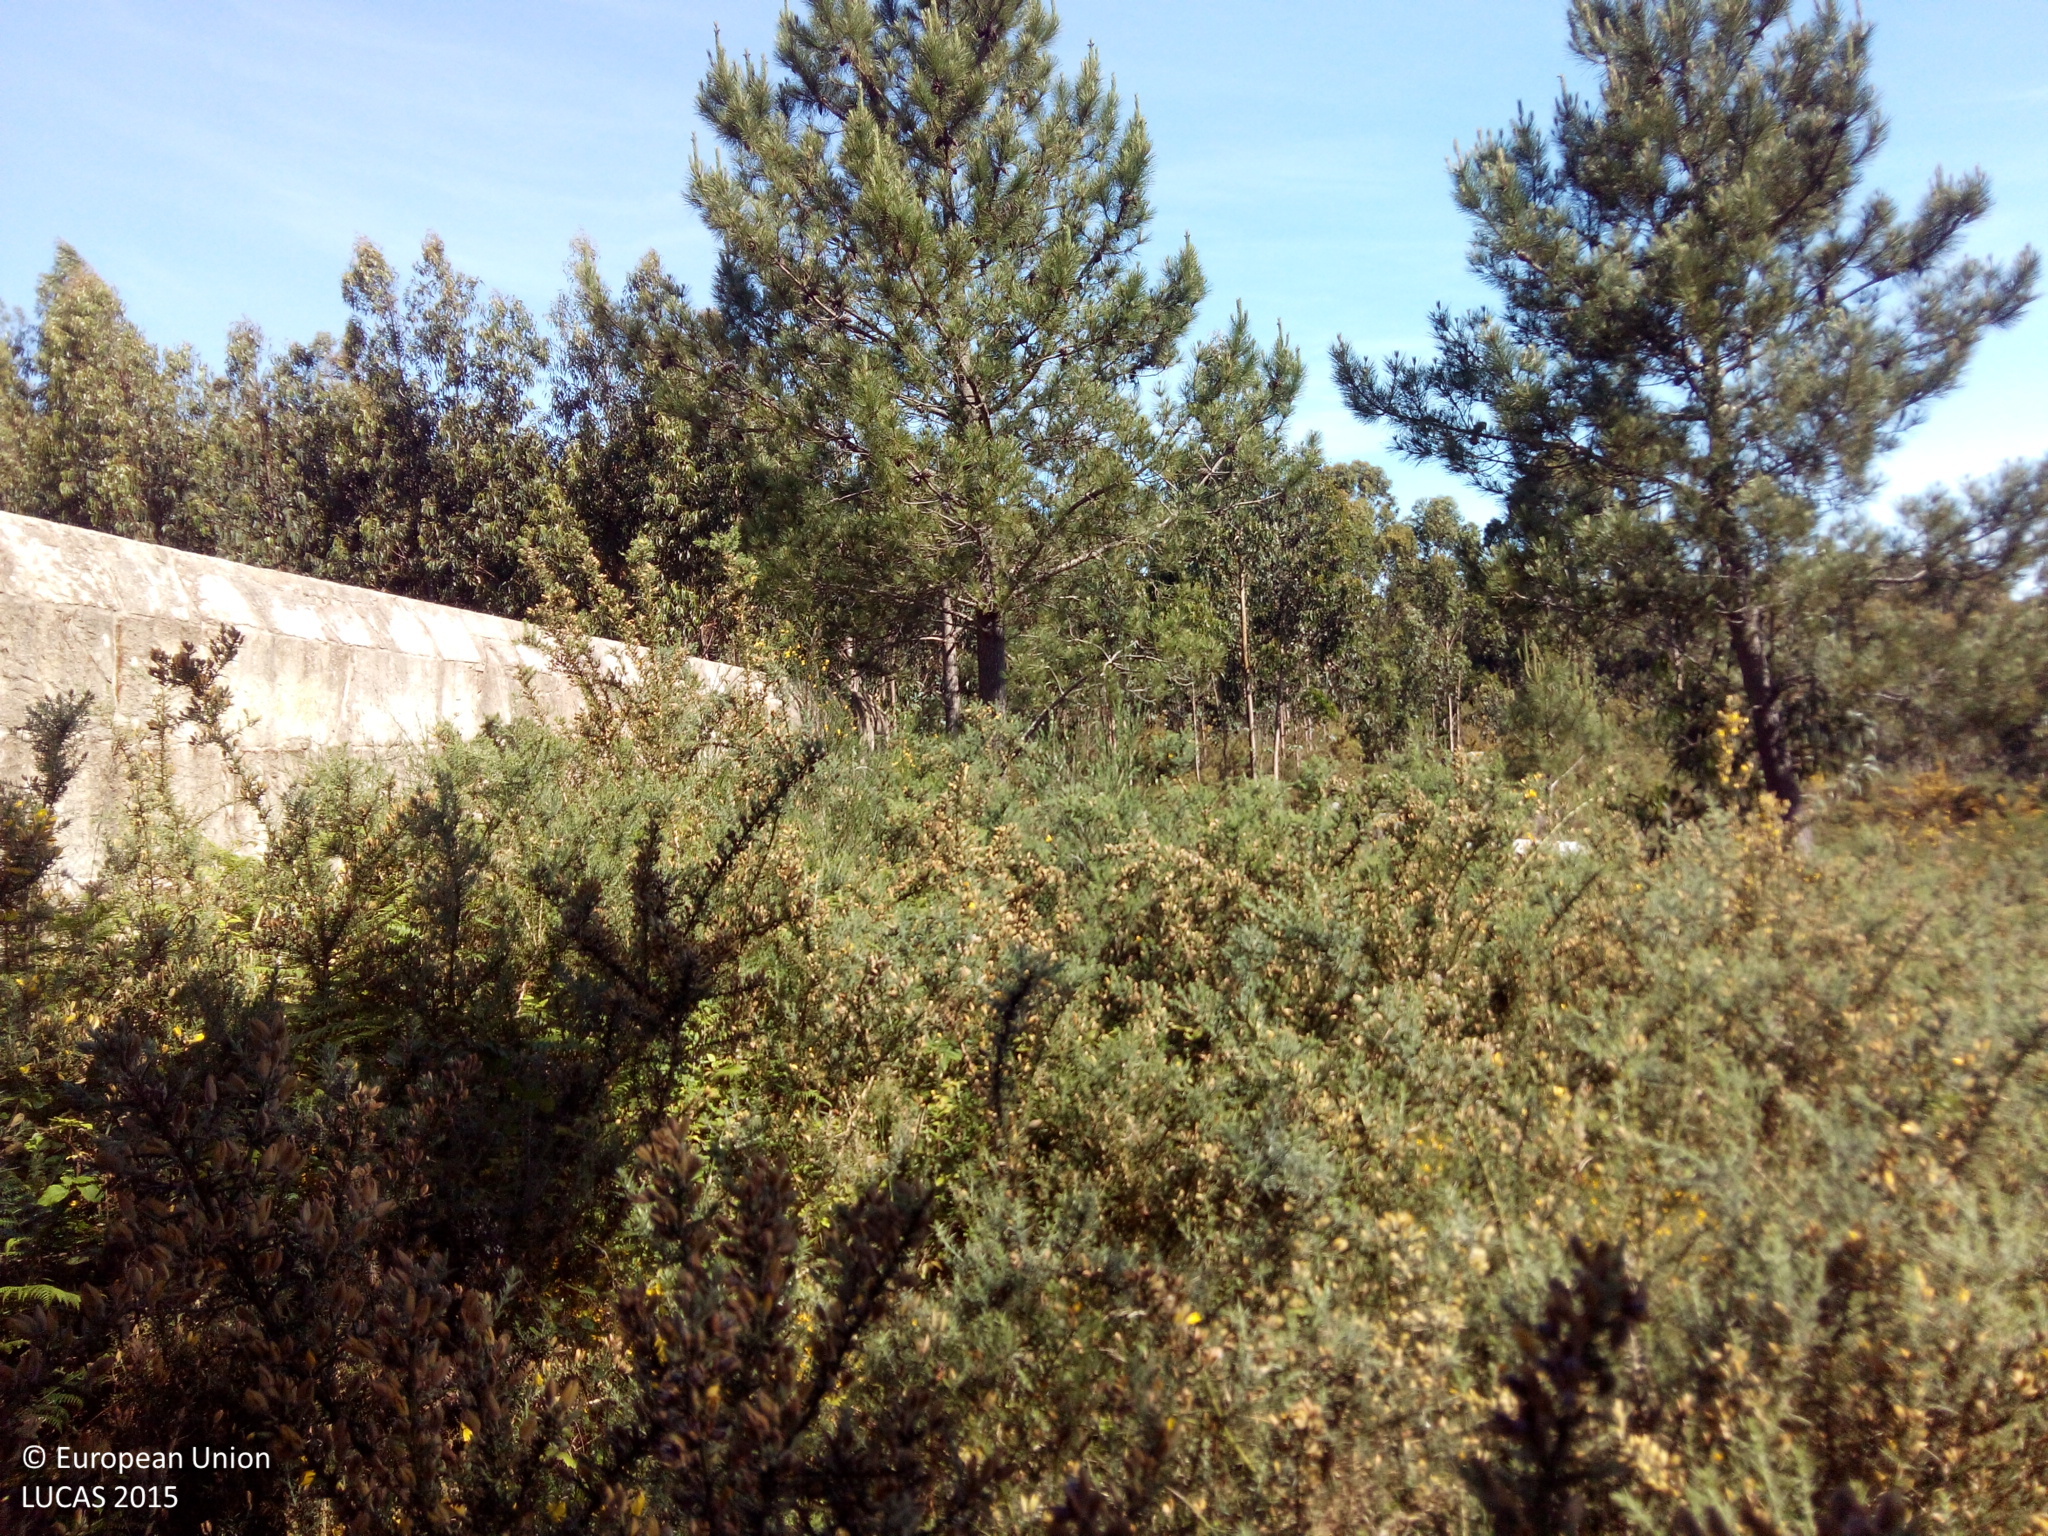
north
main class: Shrubland
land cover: Shrubland without tree cover
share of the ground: > 75 %
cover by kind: shrubs 100 %
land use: Semi-natural and natural areas not in use
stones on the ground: < 10 %
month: May
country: ES
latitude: 42.5555
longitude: -9.0051
